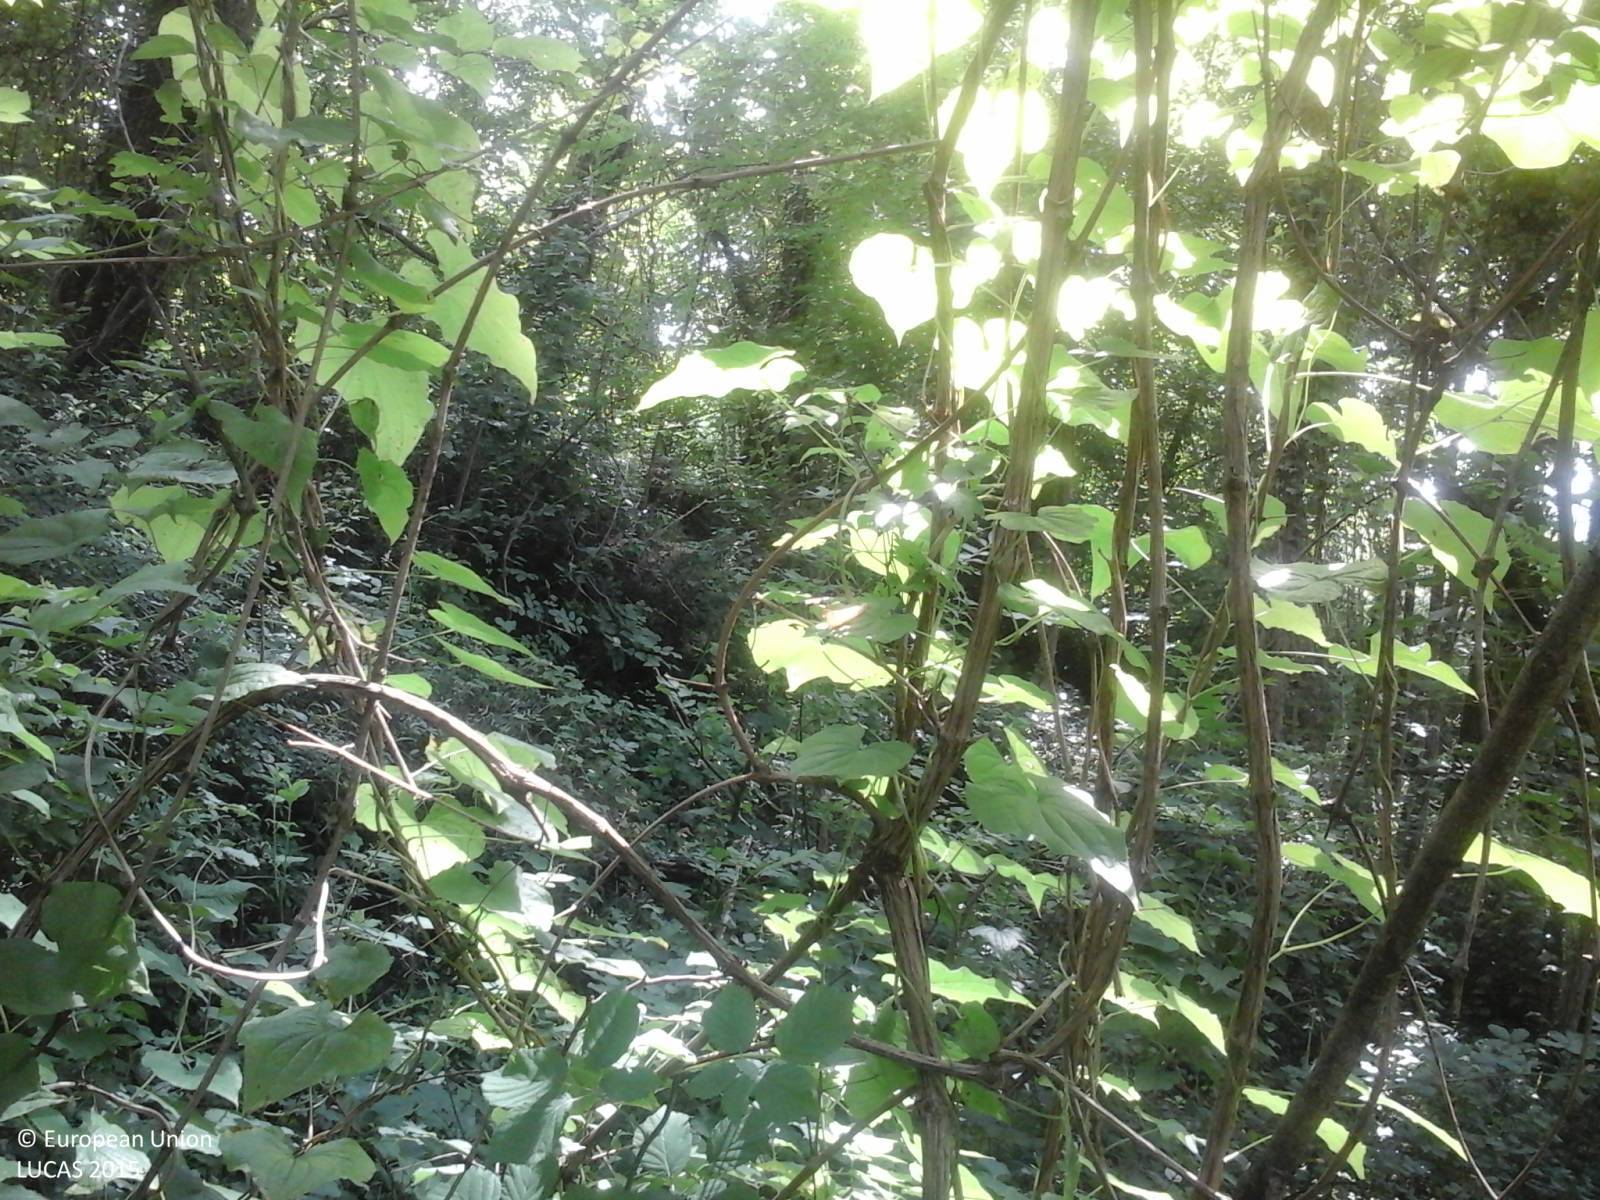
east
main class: Woodland
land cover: Broadleaved woodland
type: exotic forest
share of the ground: > 75 %
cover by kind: broadleaved forest trees 80 %, shrubs 20 %
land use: Forestry
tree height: > 5 m
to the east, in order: Broadleaved woodland; Grassland without tree/shrub cover; Broadleaved woodland; Tracks; Broadleaved woodland; Inland fresh running water; Broadleaved woodland; Electric lines; Tracks; Electric lines; Abandoned hedges; Grassland without tree/shrub cover
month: June
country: IT
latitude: 46.0861
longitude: 12.5704
